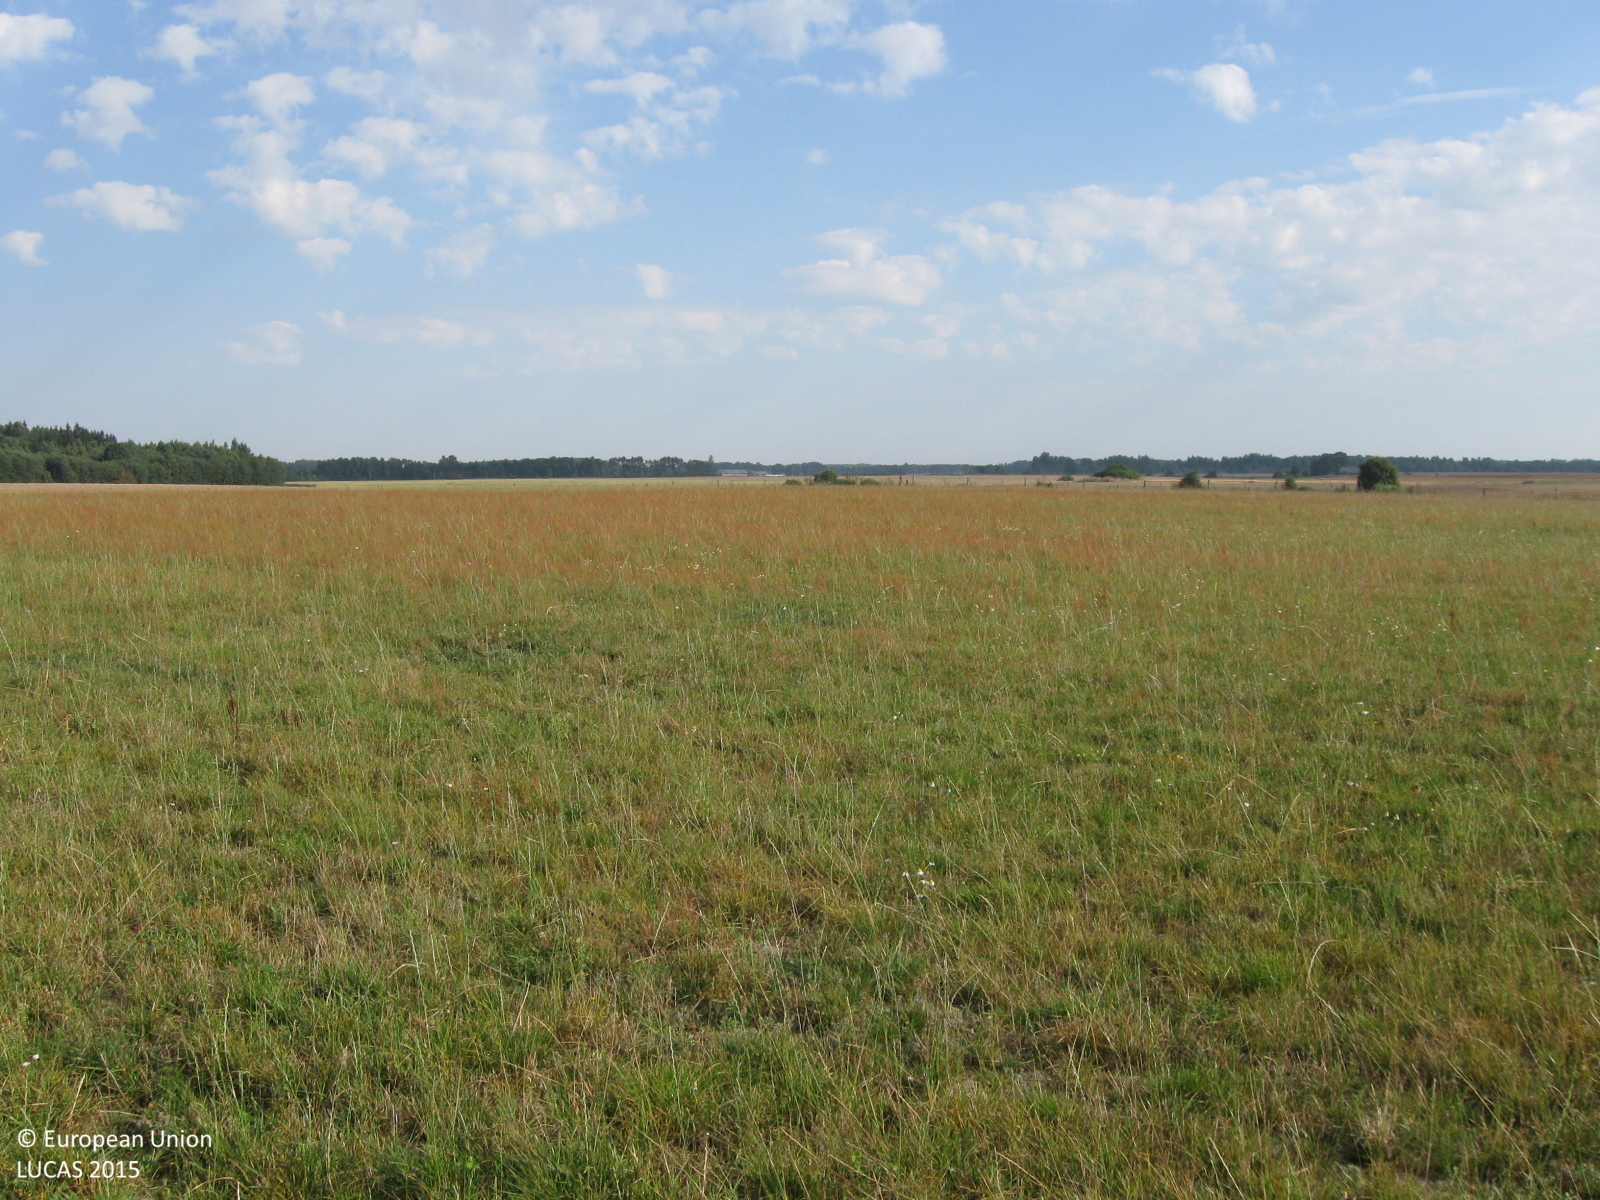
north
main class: Grassland
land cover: Grassland without tree/shrub cover
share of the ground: > 75 %
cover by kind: herbaceous plants 100 %
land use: Agriculture (excluding fallow land and kitchen gardens)
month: August
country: LT
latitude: 55.4400
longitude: 22.9192
